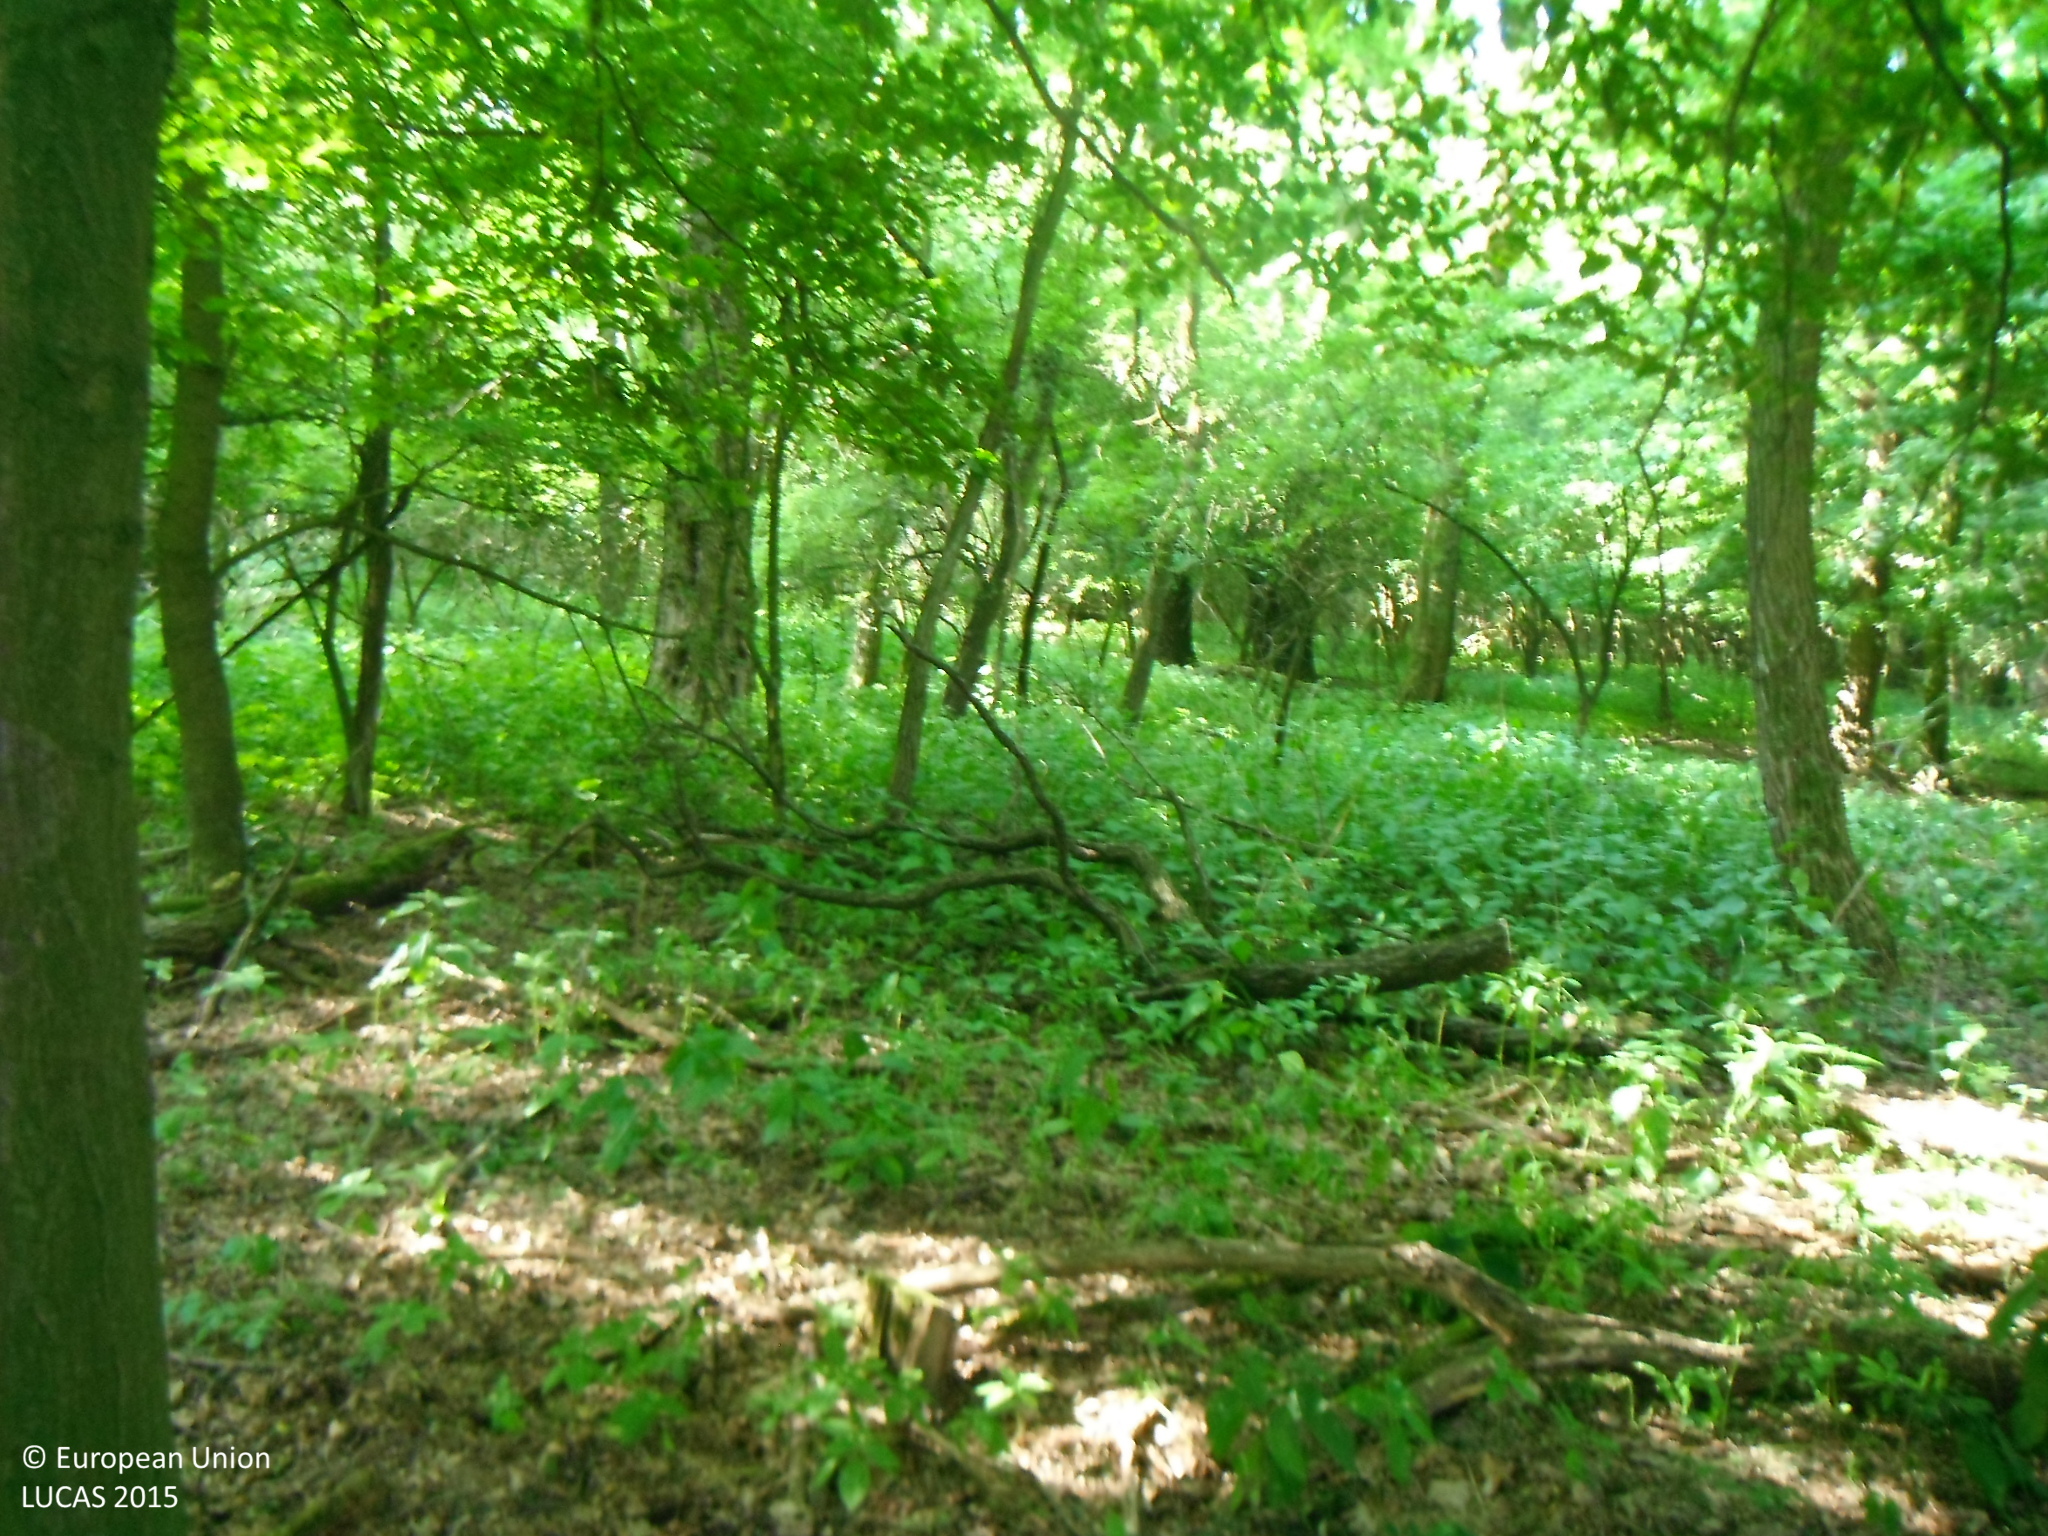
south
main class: Woodland
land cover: Broadleaved woodland
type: mesophytic deciduous forest
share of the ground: > 75 %
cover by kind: broadleaved forest trees 95 %, herbaceous plants 5 %
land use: Forestry
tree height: > 5 m
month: June
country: SK
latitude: 48.5854
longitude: 17.4531
